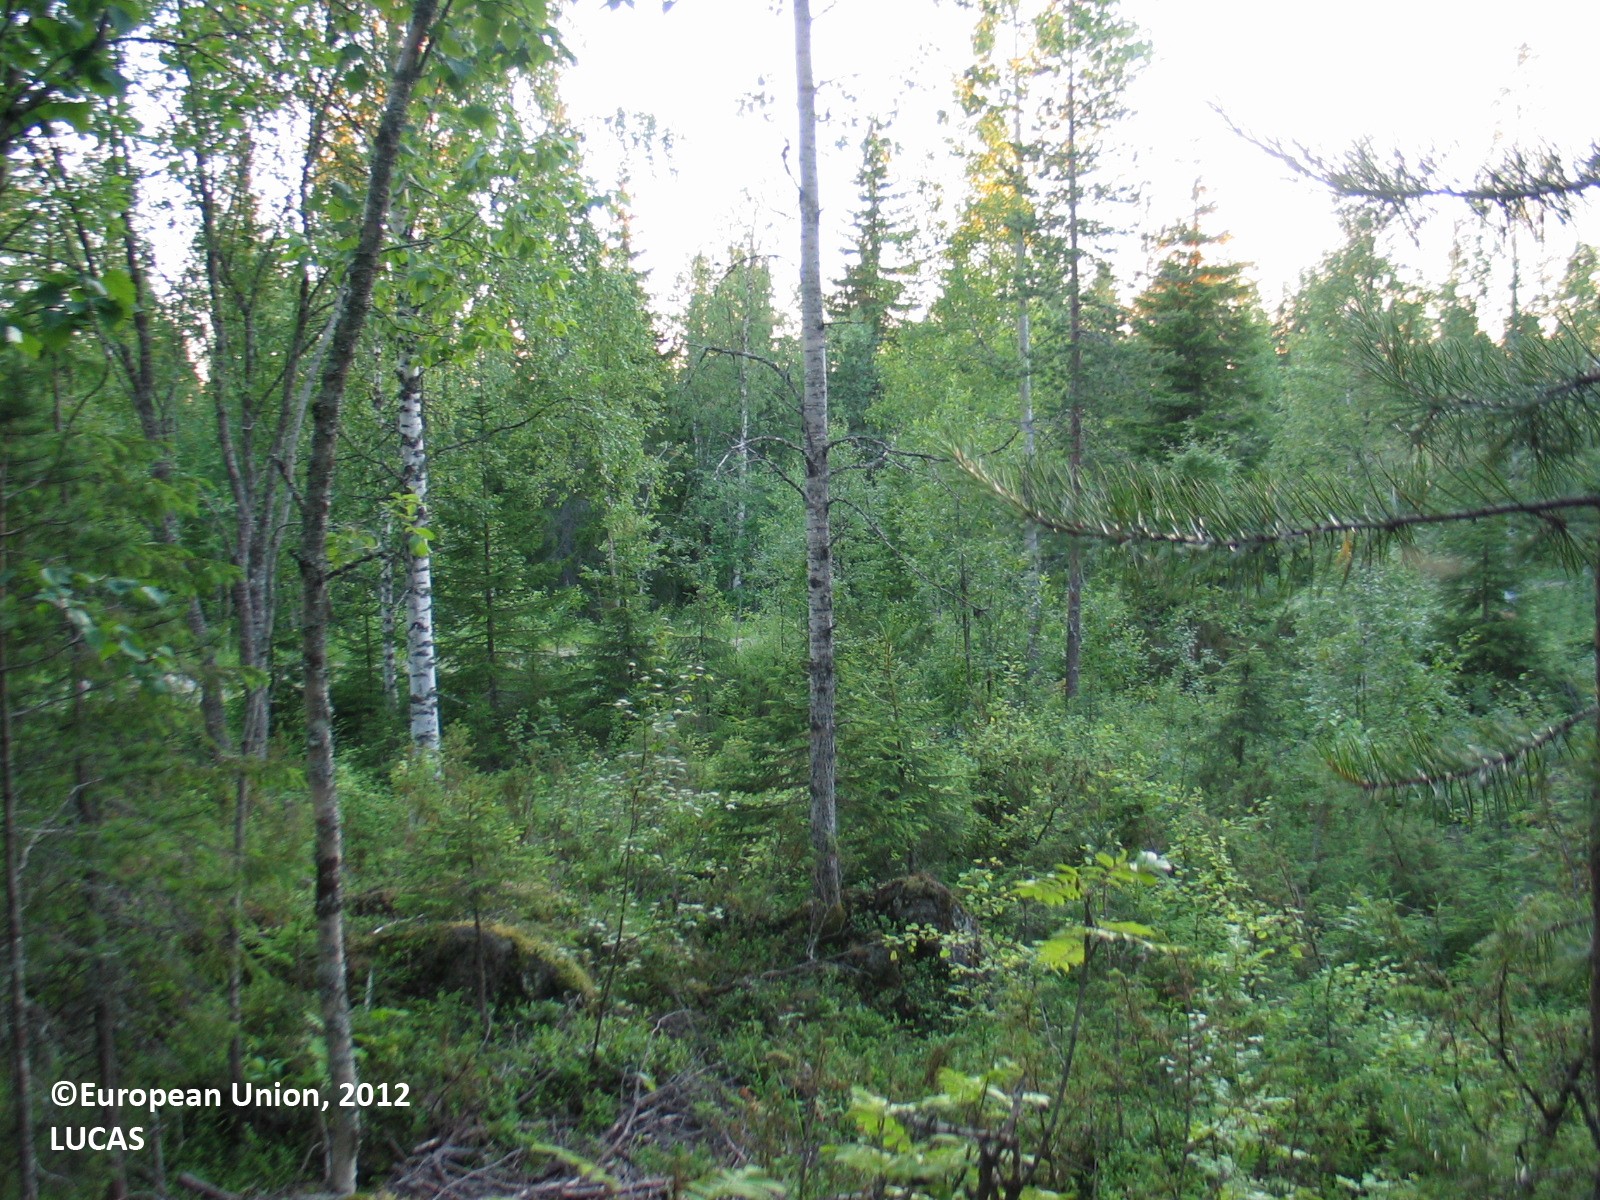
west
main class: Woodland
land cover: Other mixed woodland
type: boreal forest
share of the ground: 25 - 50 %
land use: Forestry
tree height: > 5 m
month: July
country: FI
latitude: 65.8960
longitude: 25.0059
